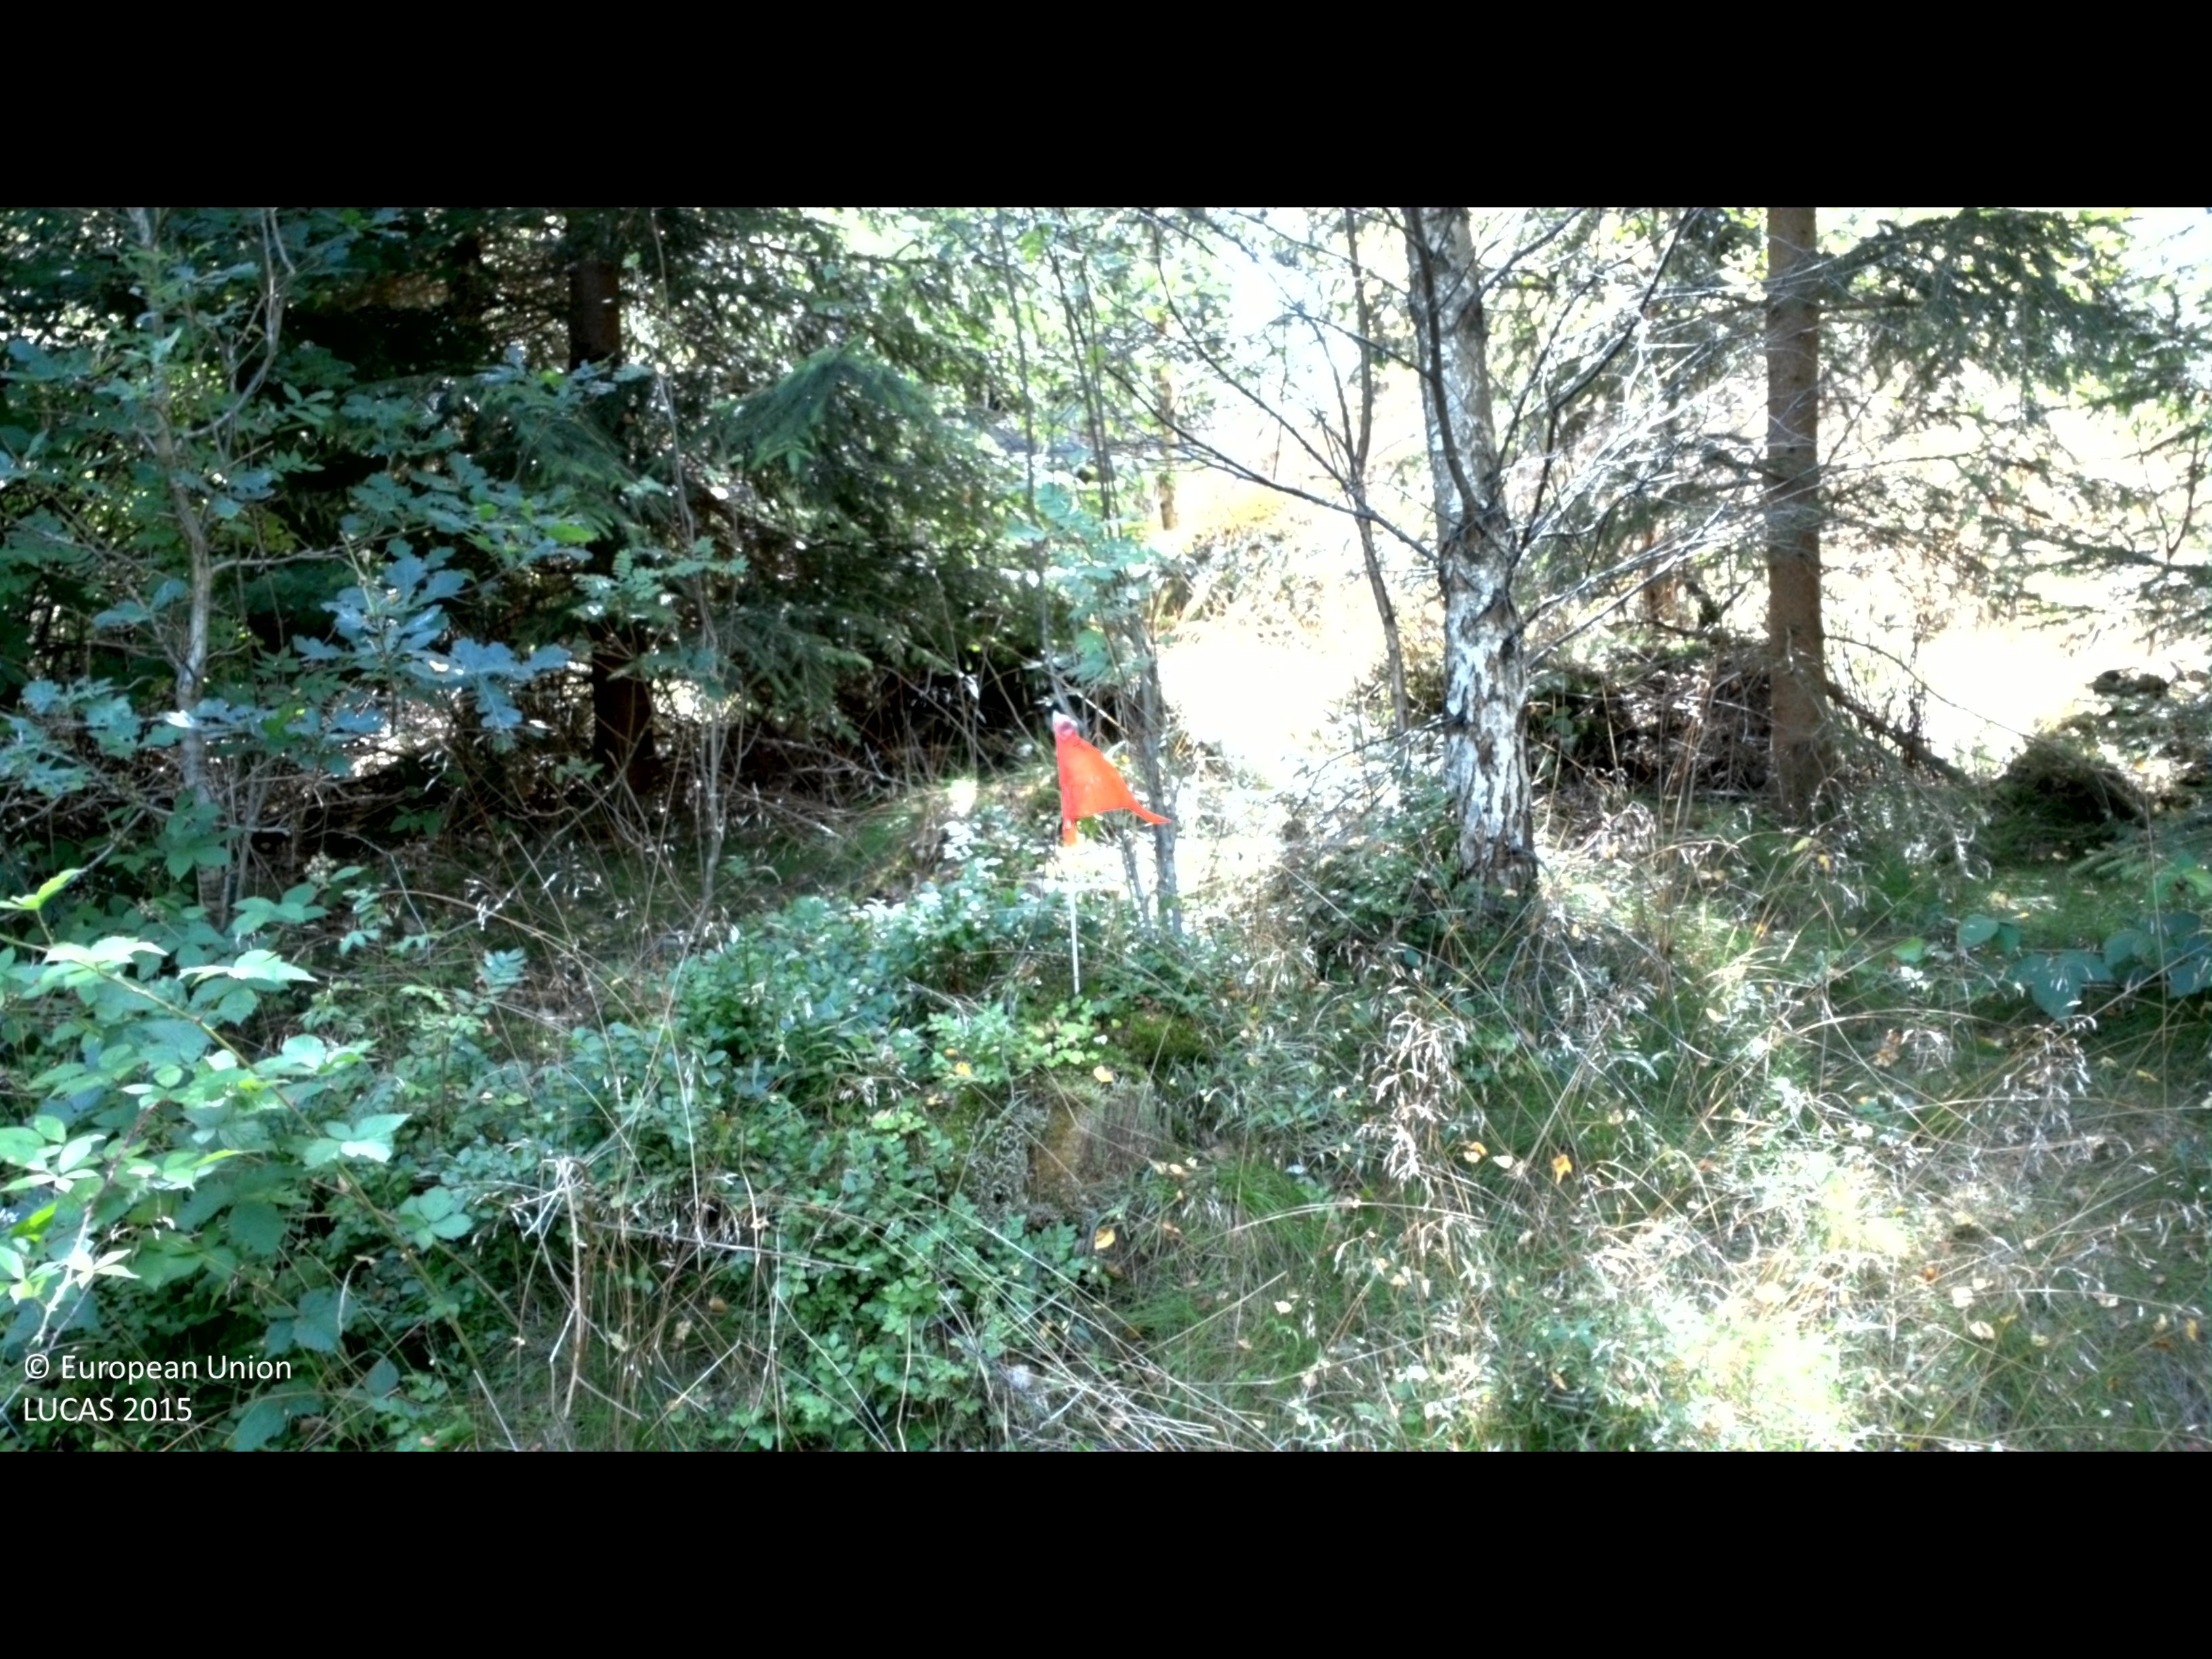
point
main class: Woodland
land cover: Spruce dominated mixed woodland
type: boreal forest
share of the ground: 50 - 75 %
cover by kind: coniferous forest trees 40 %, herbaceous plants 30 %, broadleaved forest trees 25 %, shrubs 5 %
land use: Forestry
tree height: > 5 m
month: August
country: SE
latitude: 56.2867
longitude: 15.8969
